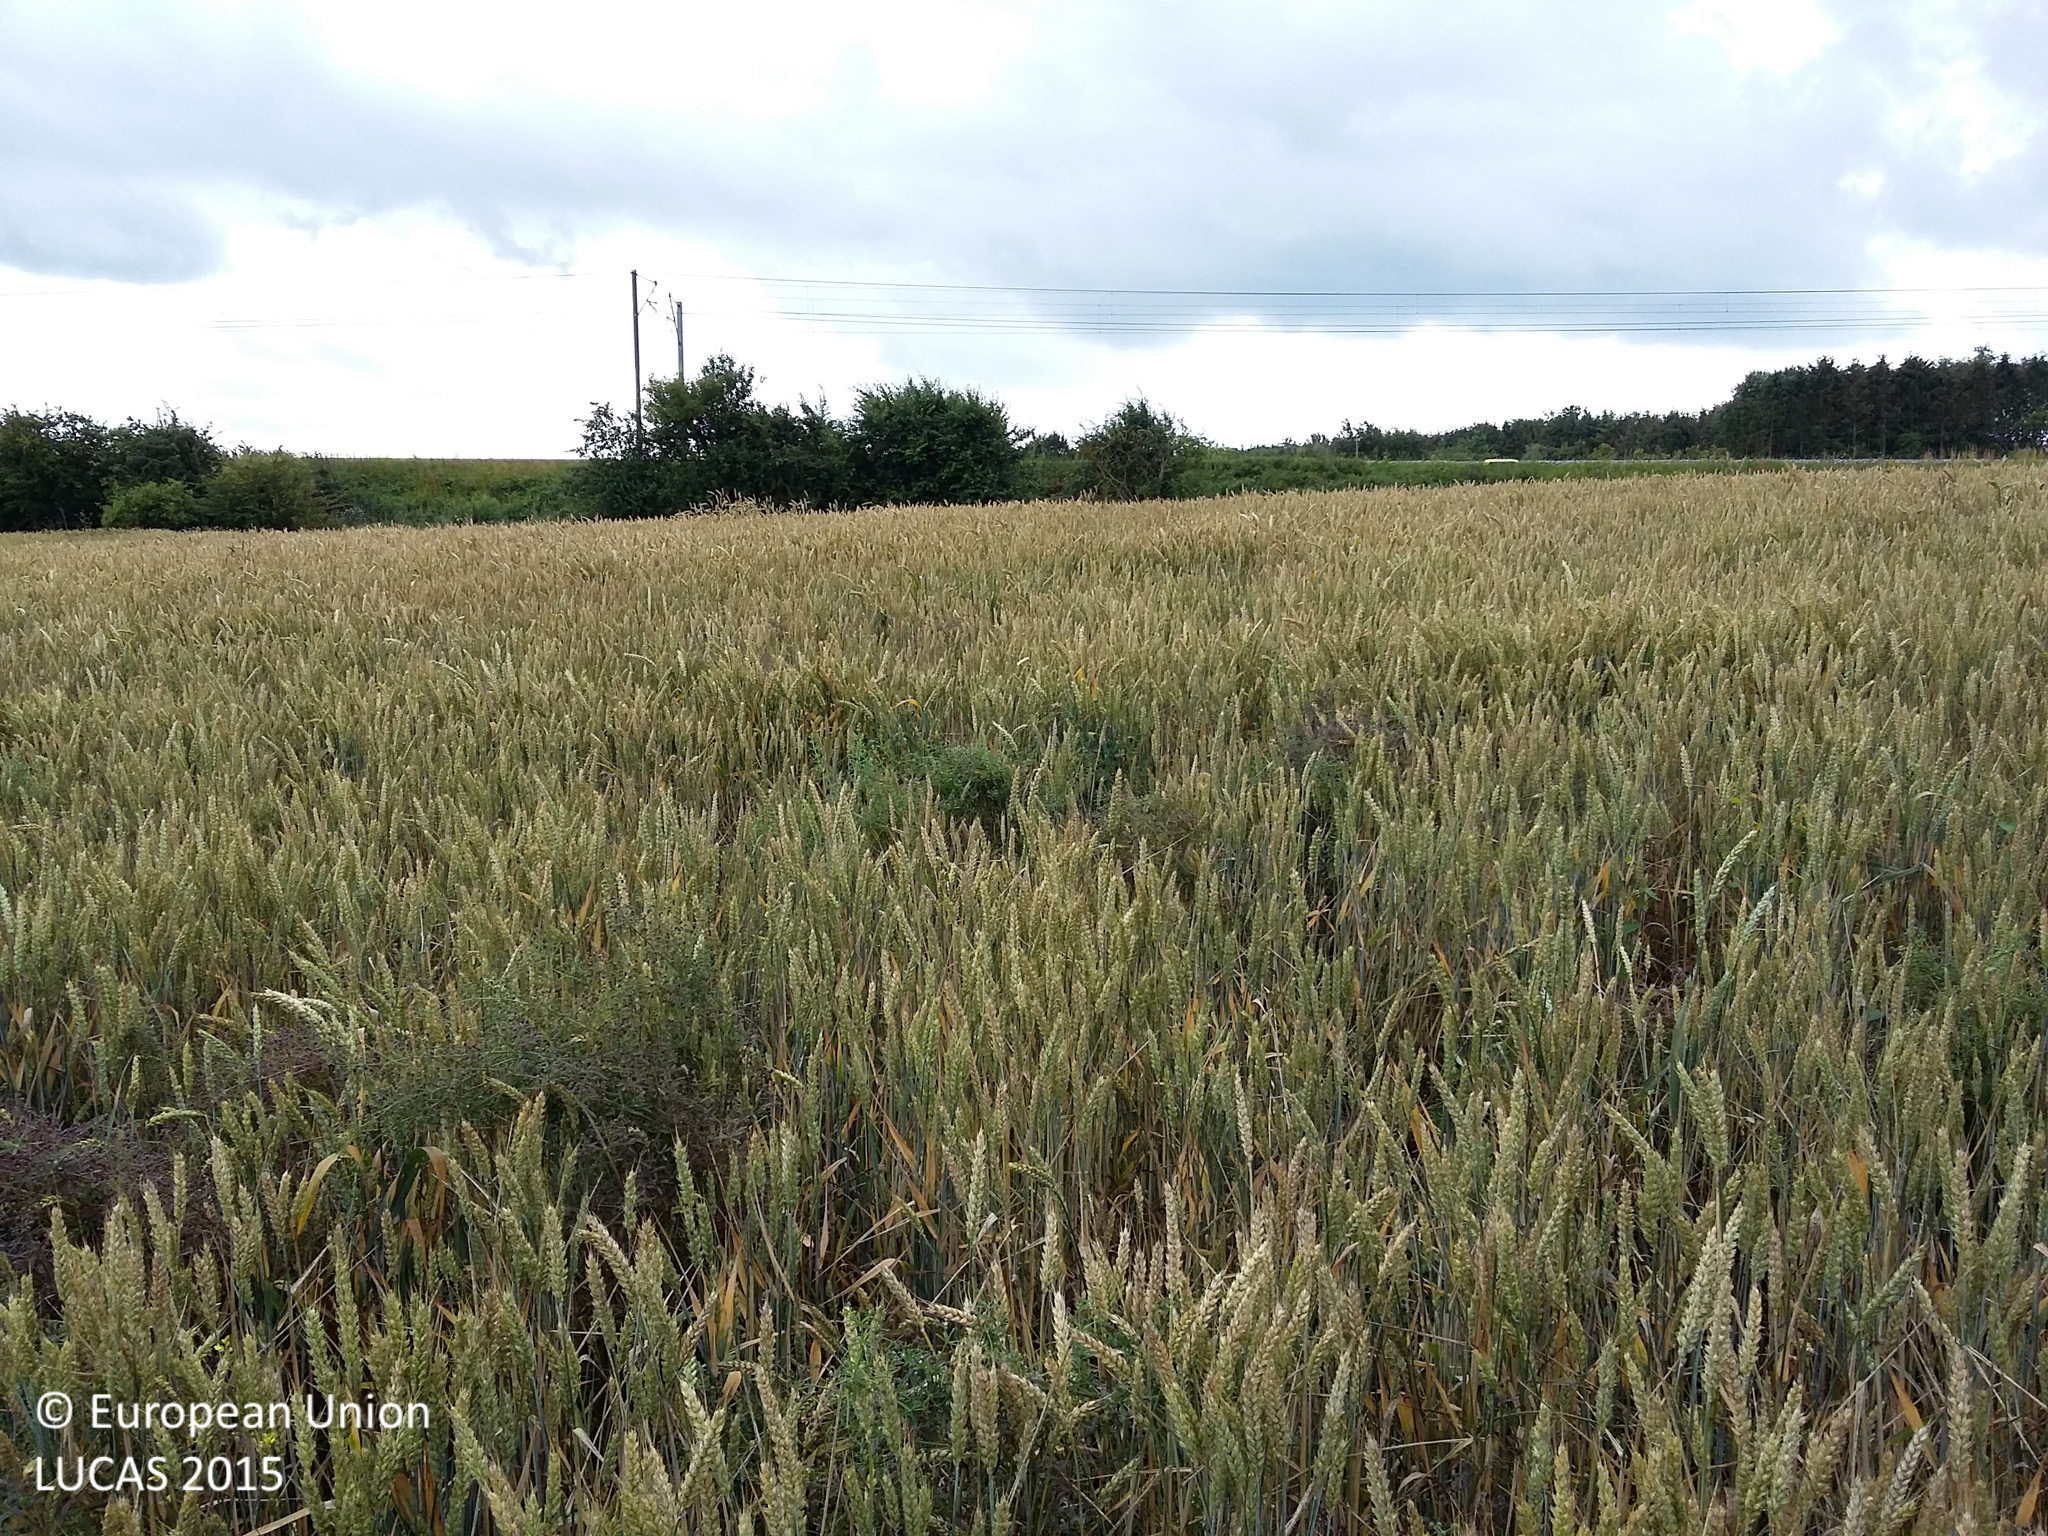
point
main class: Cropland
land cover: Common wheat
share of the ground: > 75 %
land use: Agriculture (excluding fallow land and kitchen gardens)
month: July
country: DK
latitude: 55.8106
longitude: 12.1203
